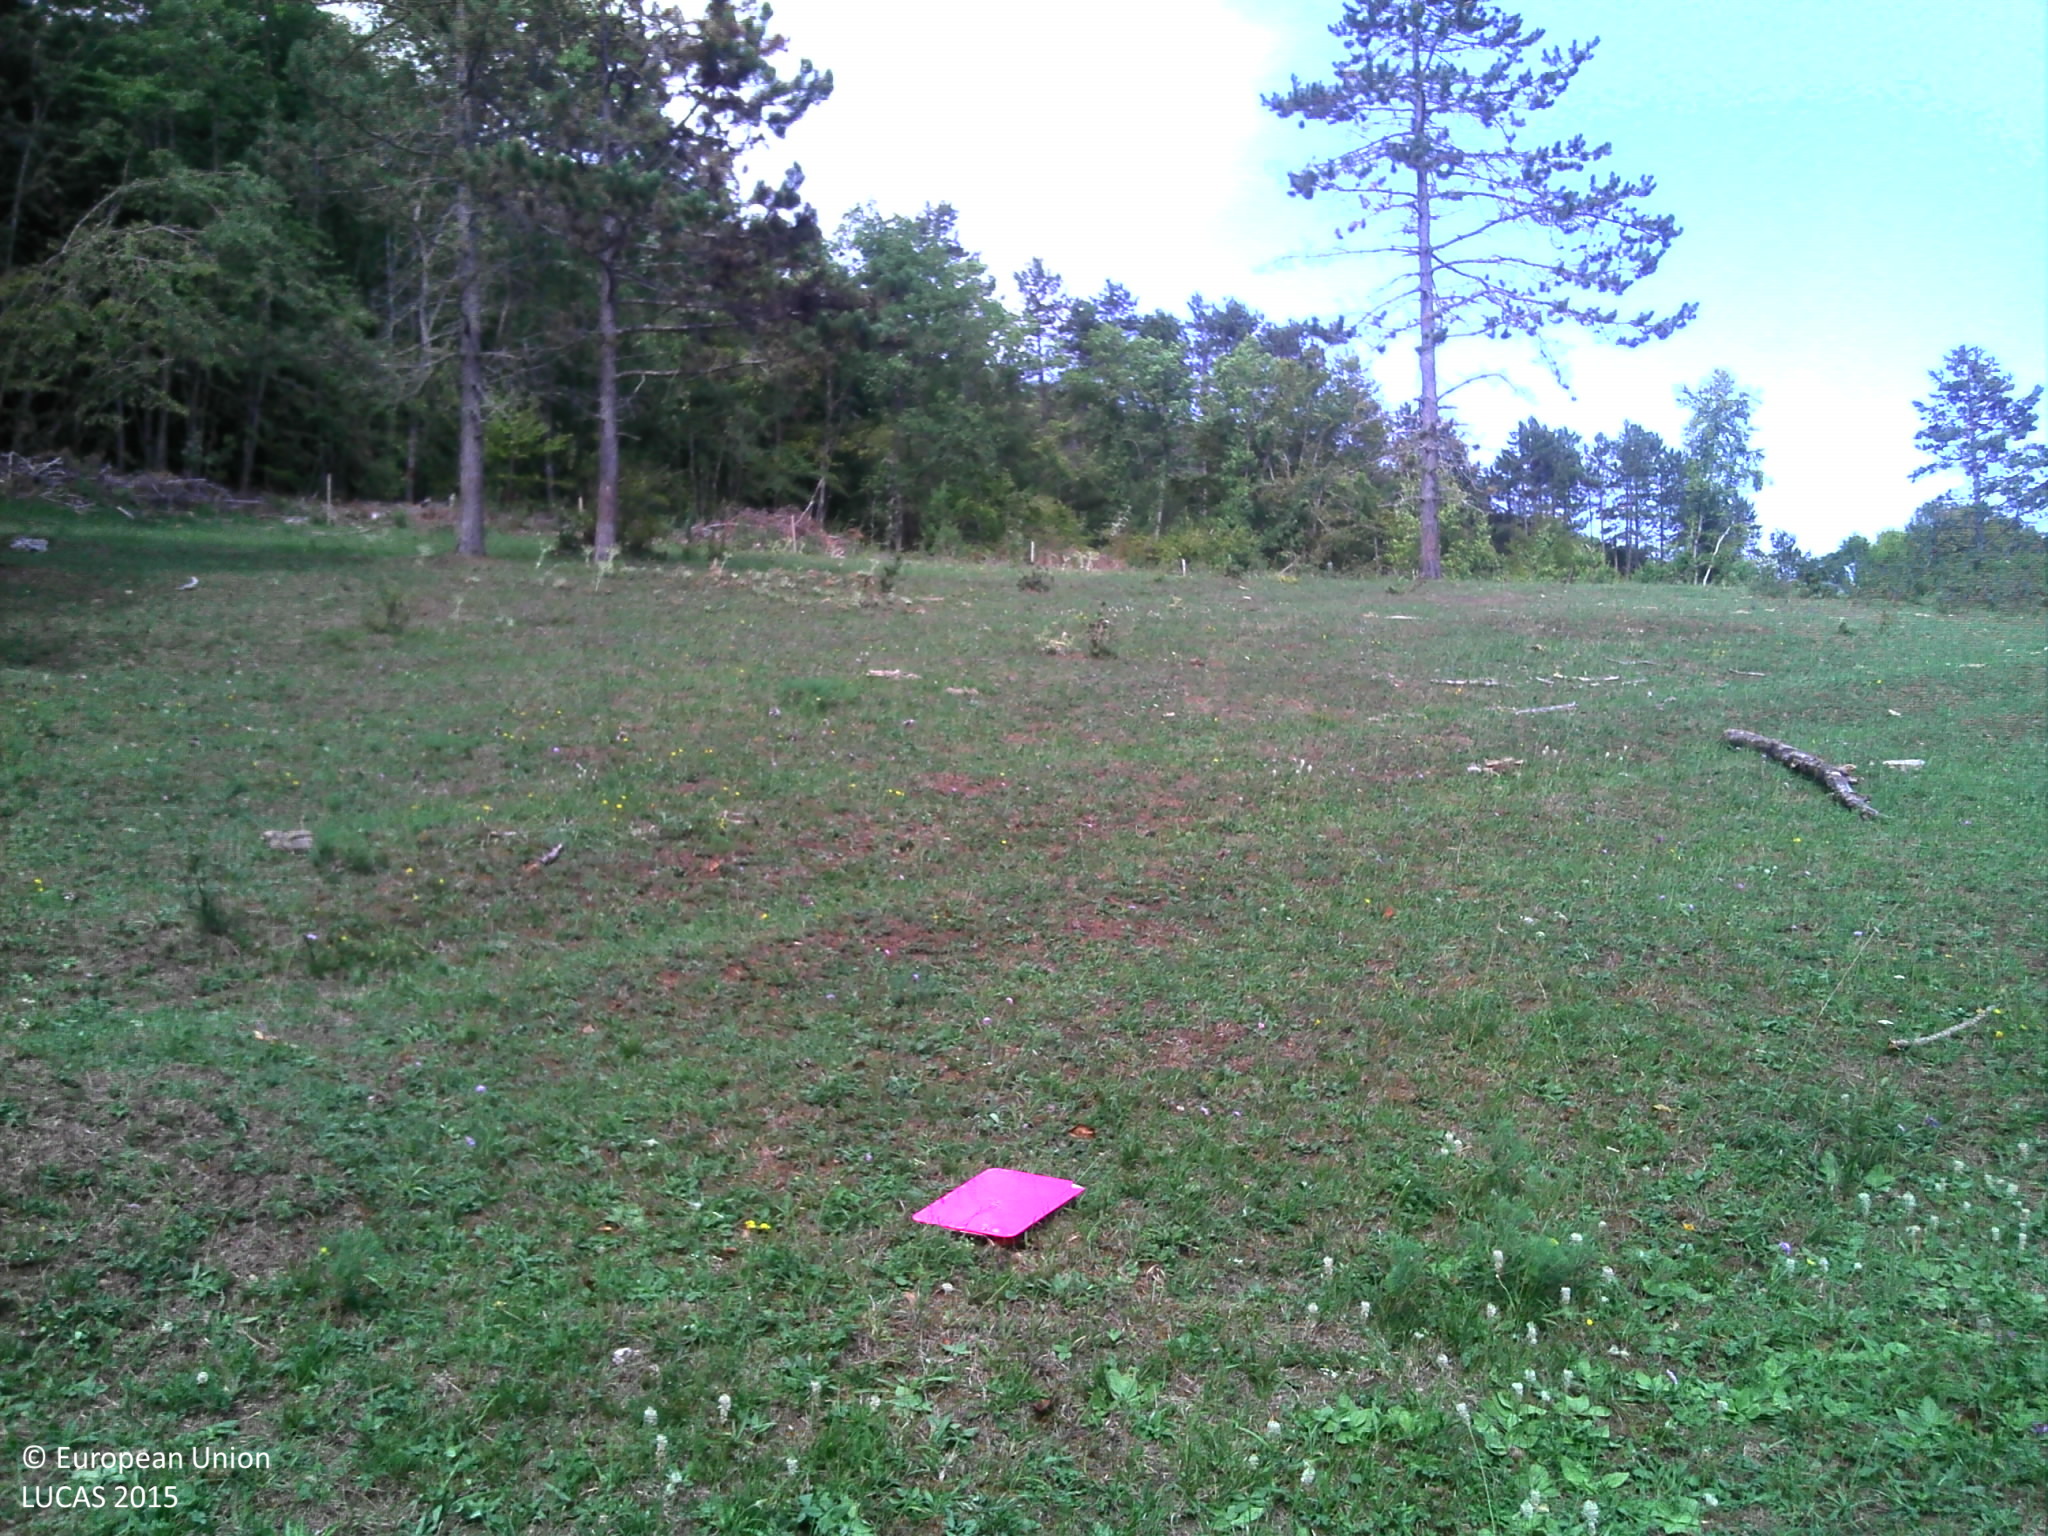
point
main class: Grassland
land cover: Grassland without tree/shrub cover
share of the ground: > 75 %
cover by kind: herbaceous plants 100 %
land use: Agriculture (excluding fallow land and kitchen gardens)
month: August
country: FR
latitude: 47.2318
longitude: 4.7300
